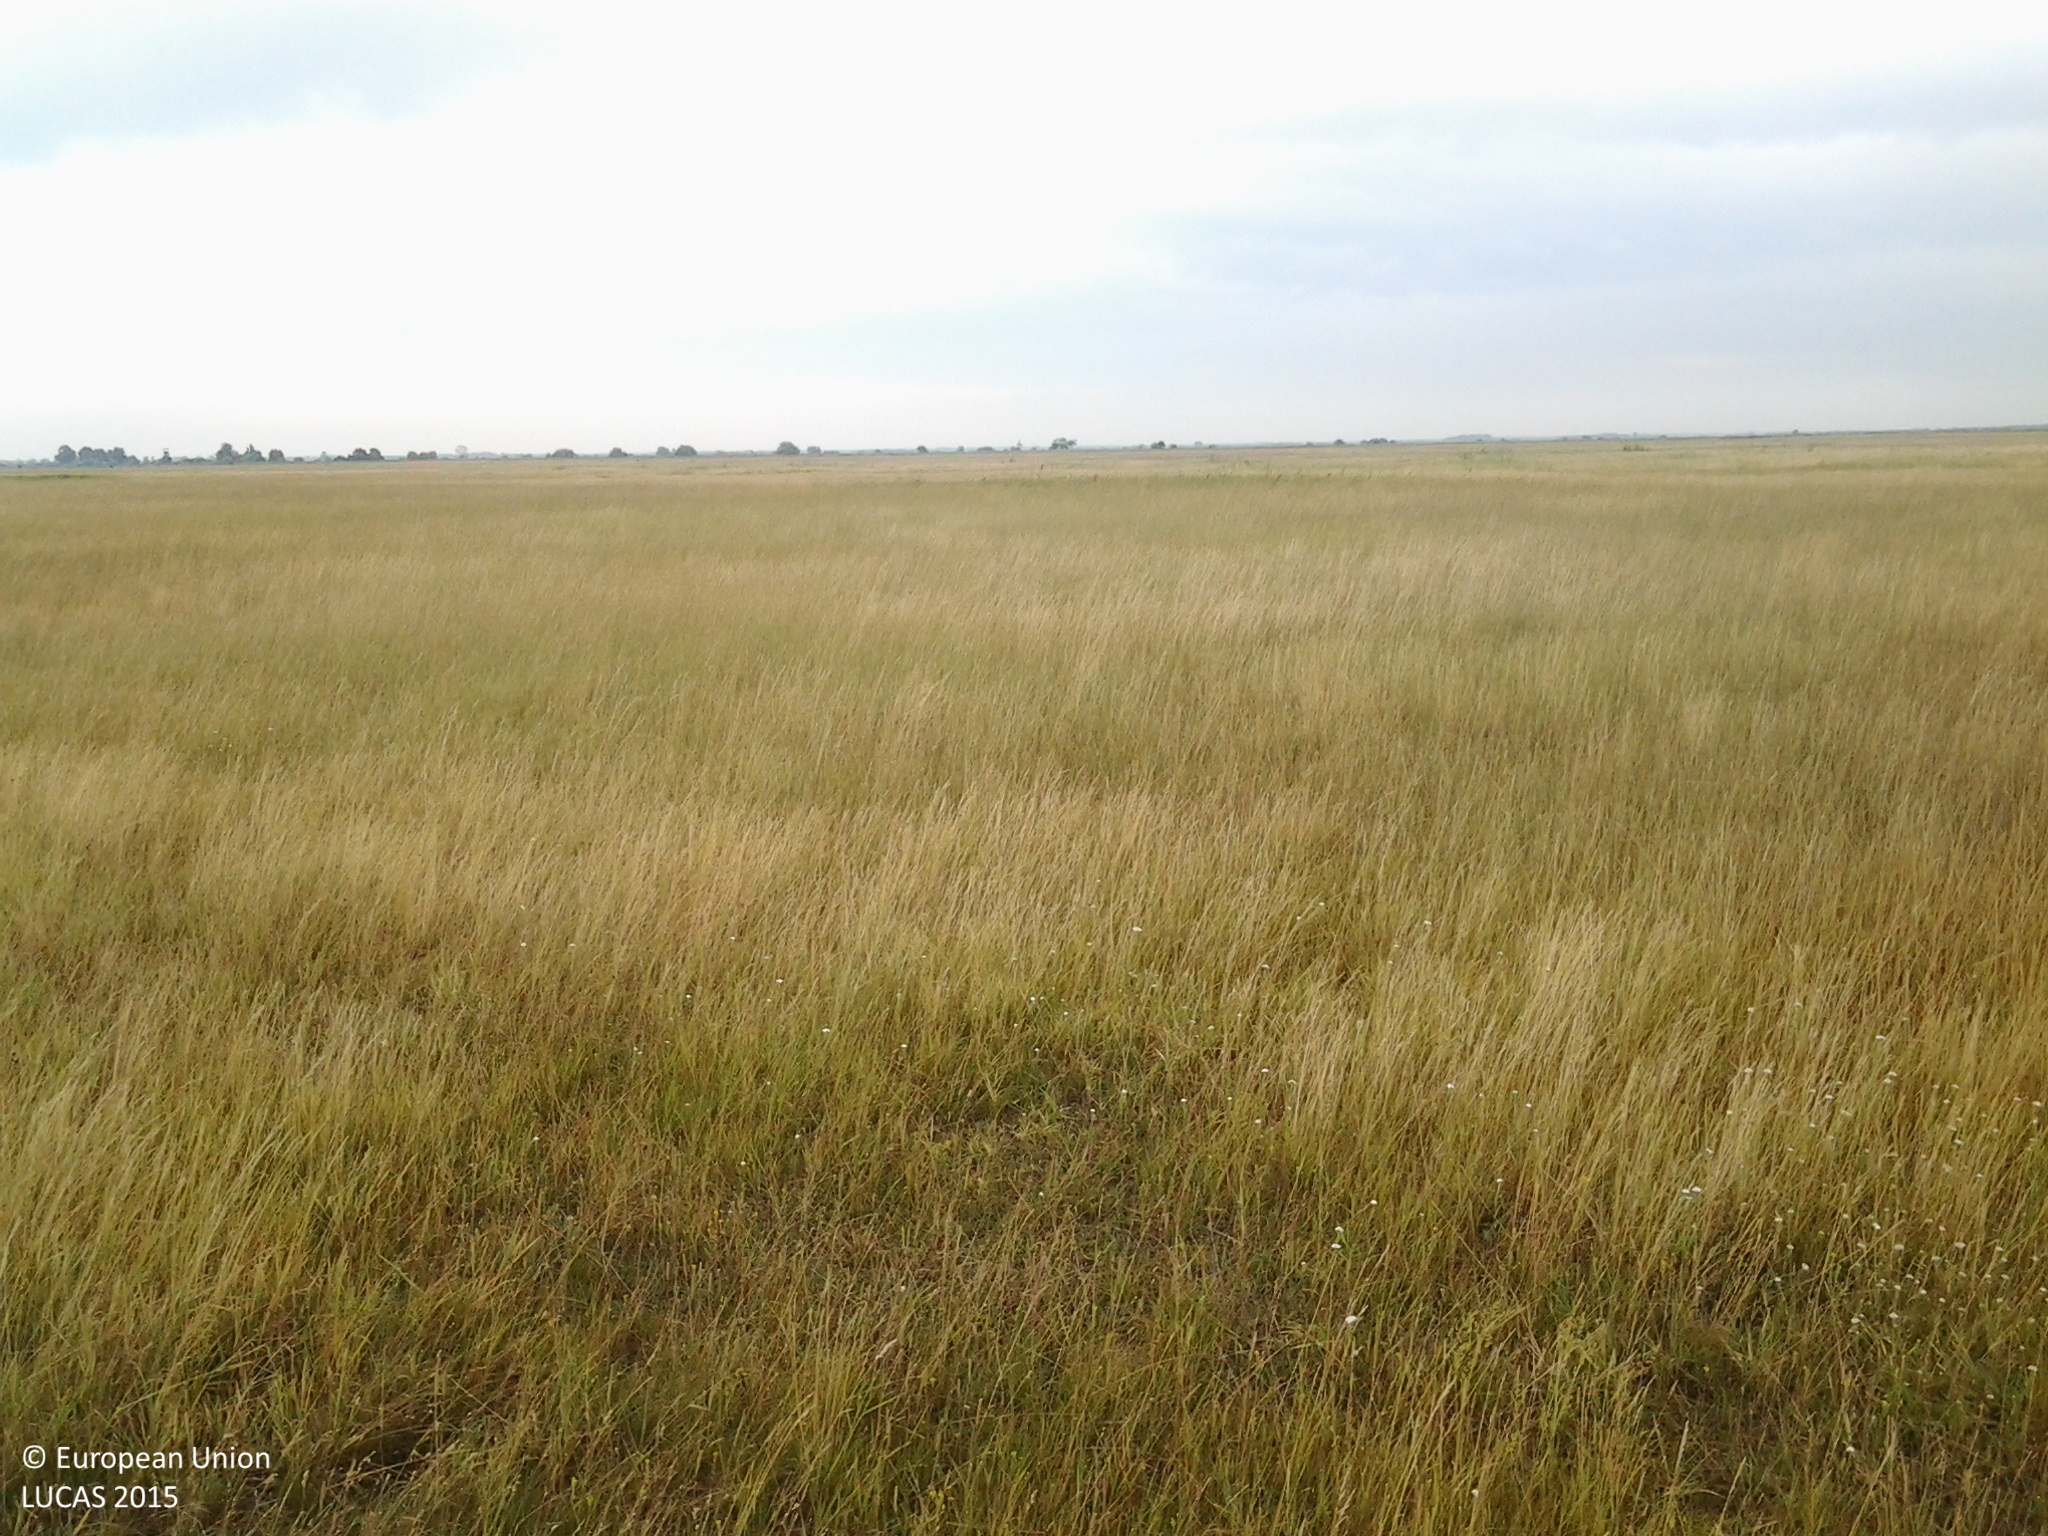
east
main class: Grassland
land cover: Grassland without tree/shrub cover
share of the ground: > 75 %
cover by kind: herbaceous plants 100 %
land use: Agriculture (excluding fallow land and kitchen gardens)
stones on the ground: < 10 %
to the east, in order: Grassland without tree/shrub cover
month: July
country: HU
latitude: 47.0821
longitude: 19.1447
